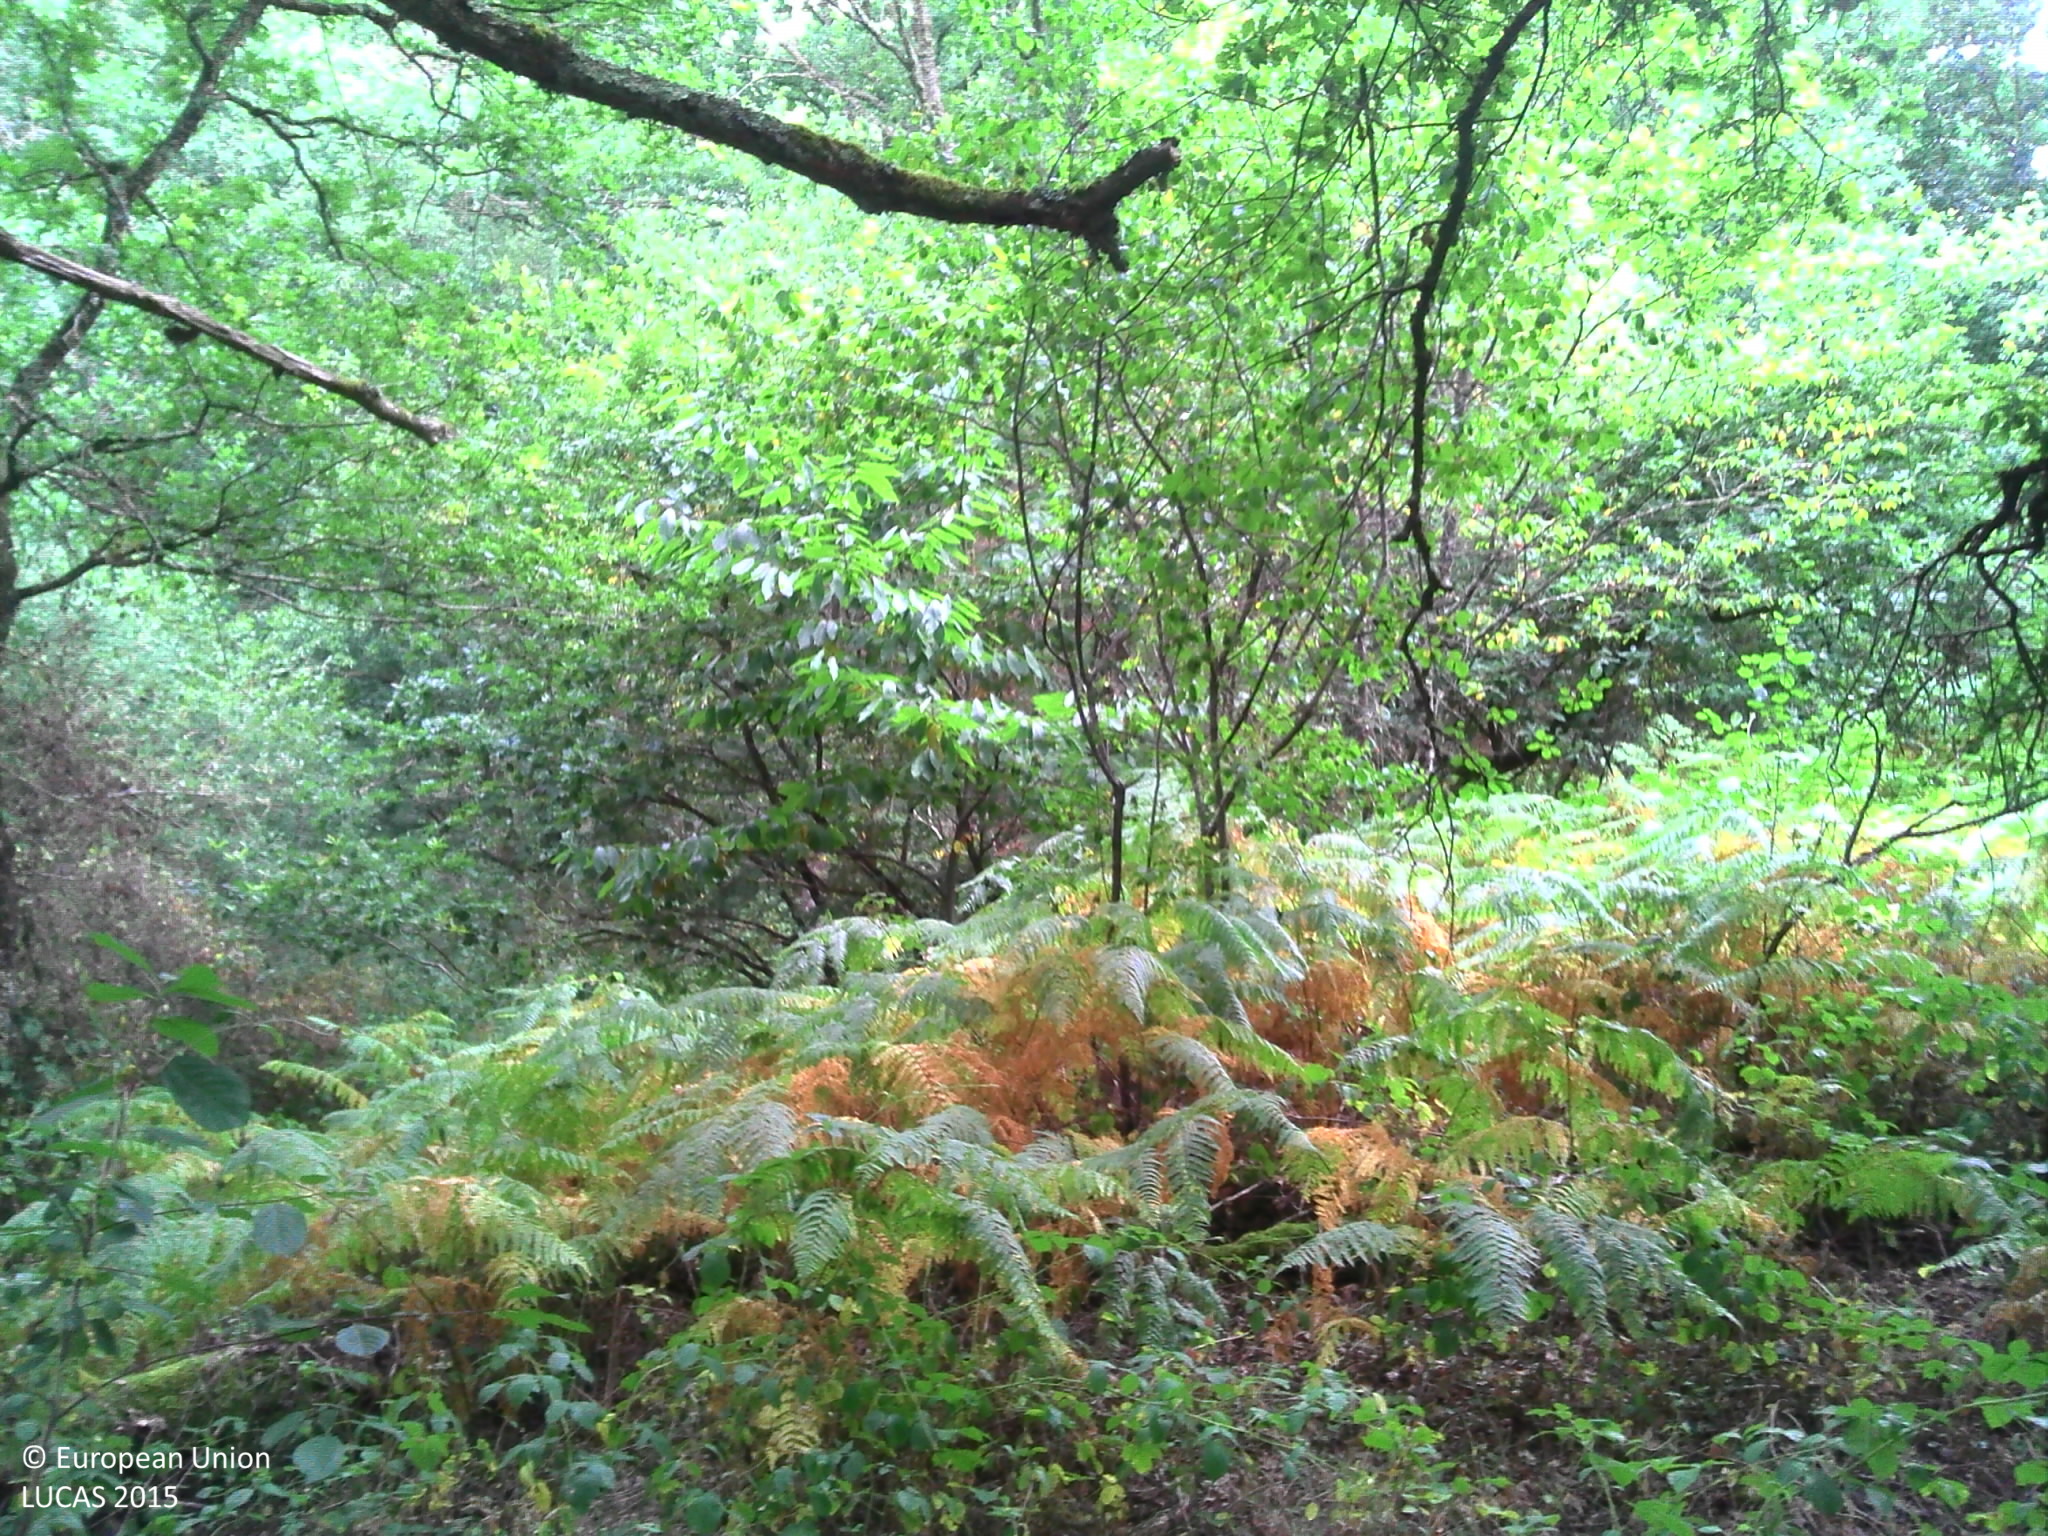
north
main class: Woodland
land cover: Broadleaved woodland
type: mesophytic deciduous forest
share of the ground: > 75 %
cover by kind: broadleaved forest trees 85 %, herbaceous plants 10 %, shrubs 5 %
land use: Forestry
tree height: > 5 m
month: July
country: FR
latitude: 46.4006
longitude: 1.6014
